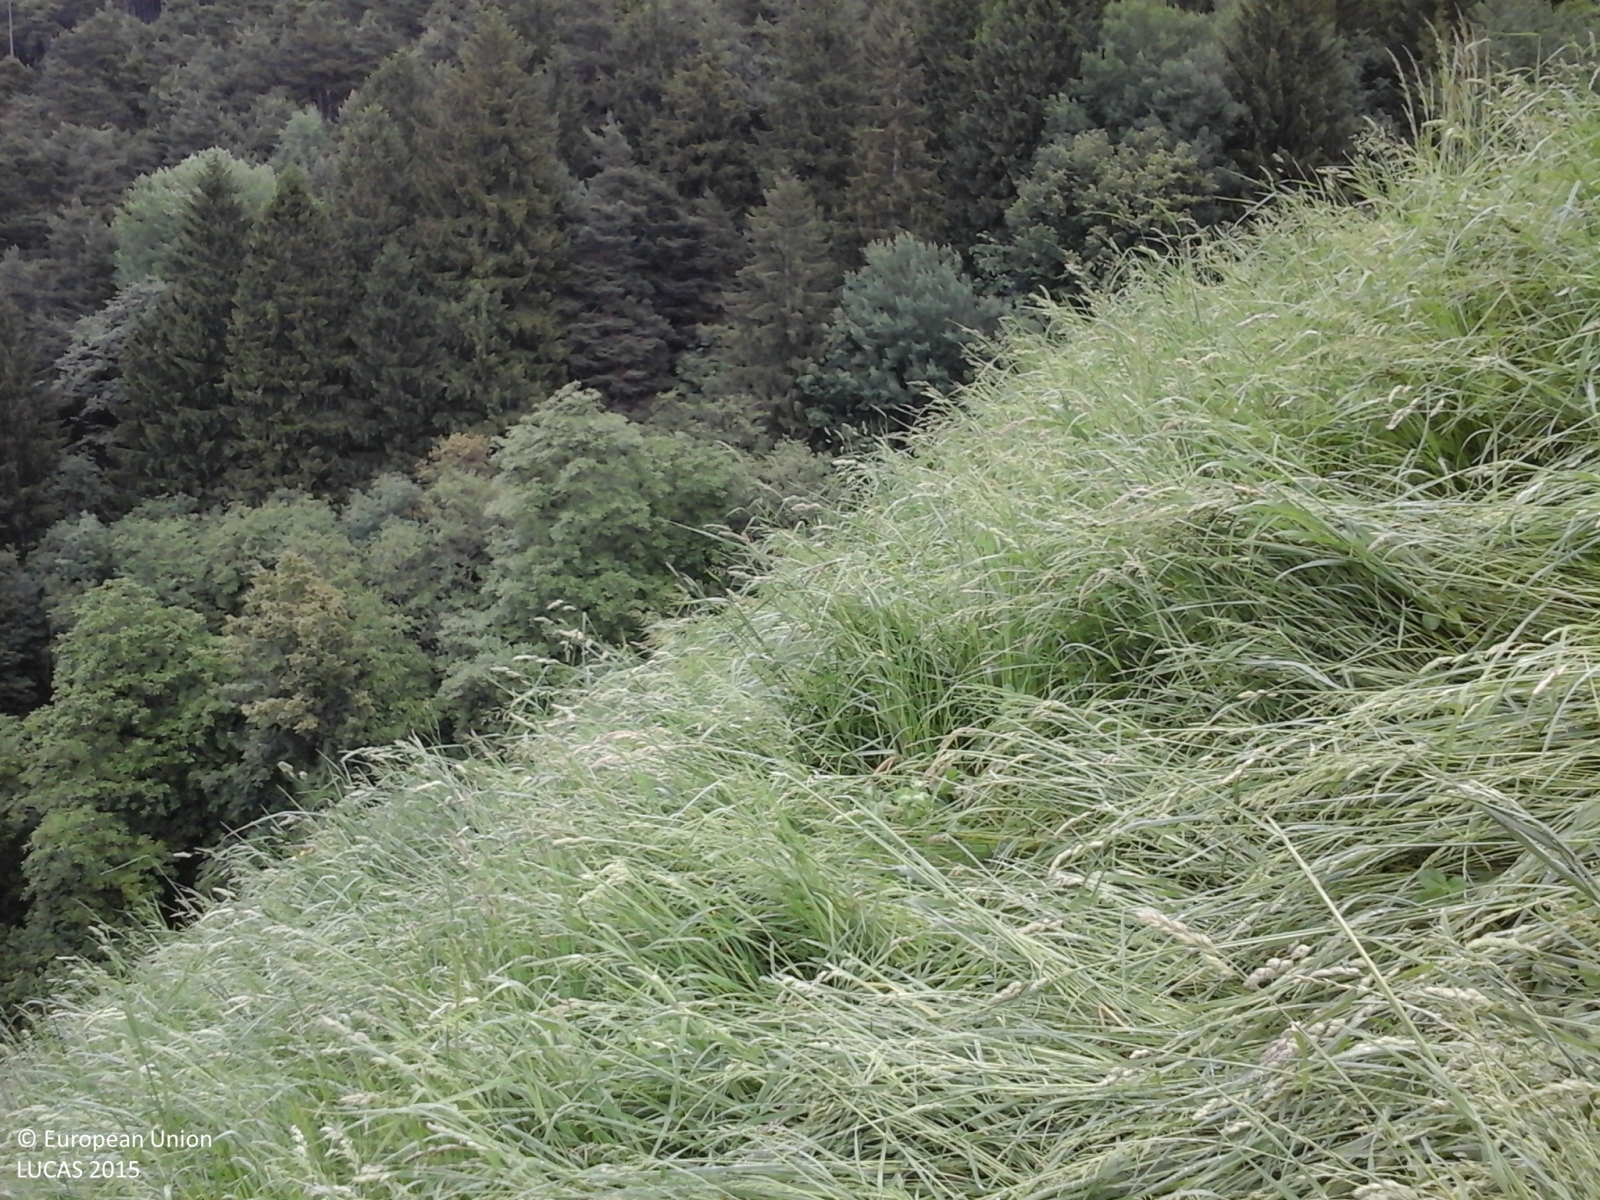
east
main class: Grassland
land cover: Grassland without tree/shrub cover
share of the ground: > 75 %
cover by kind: herbaceous plants 100 %
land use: Agriculture (excluding fallow land and kitchen gardens)
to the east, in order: Grassland without tree/shrub cover; Tracks; Broadleaved woodland; Inland fresh running water; Broadleaved woodland; Electric lines; Broadleaved woodland
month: May
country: IT
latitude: 46.6522
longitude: 11.0572
